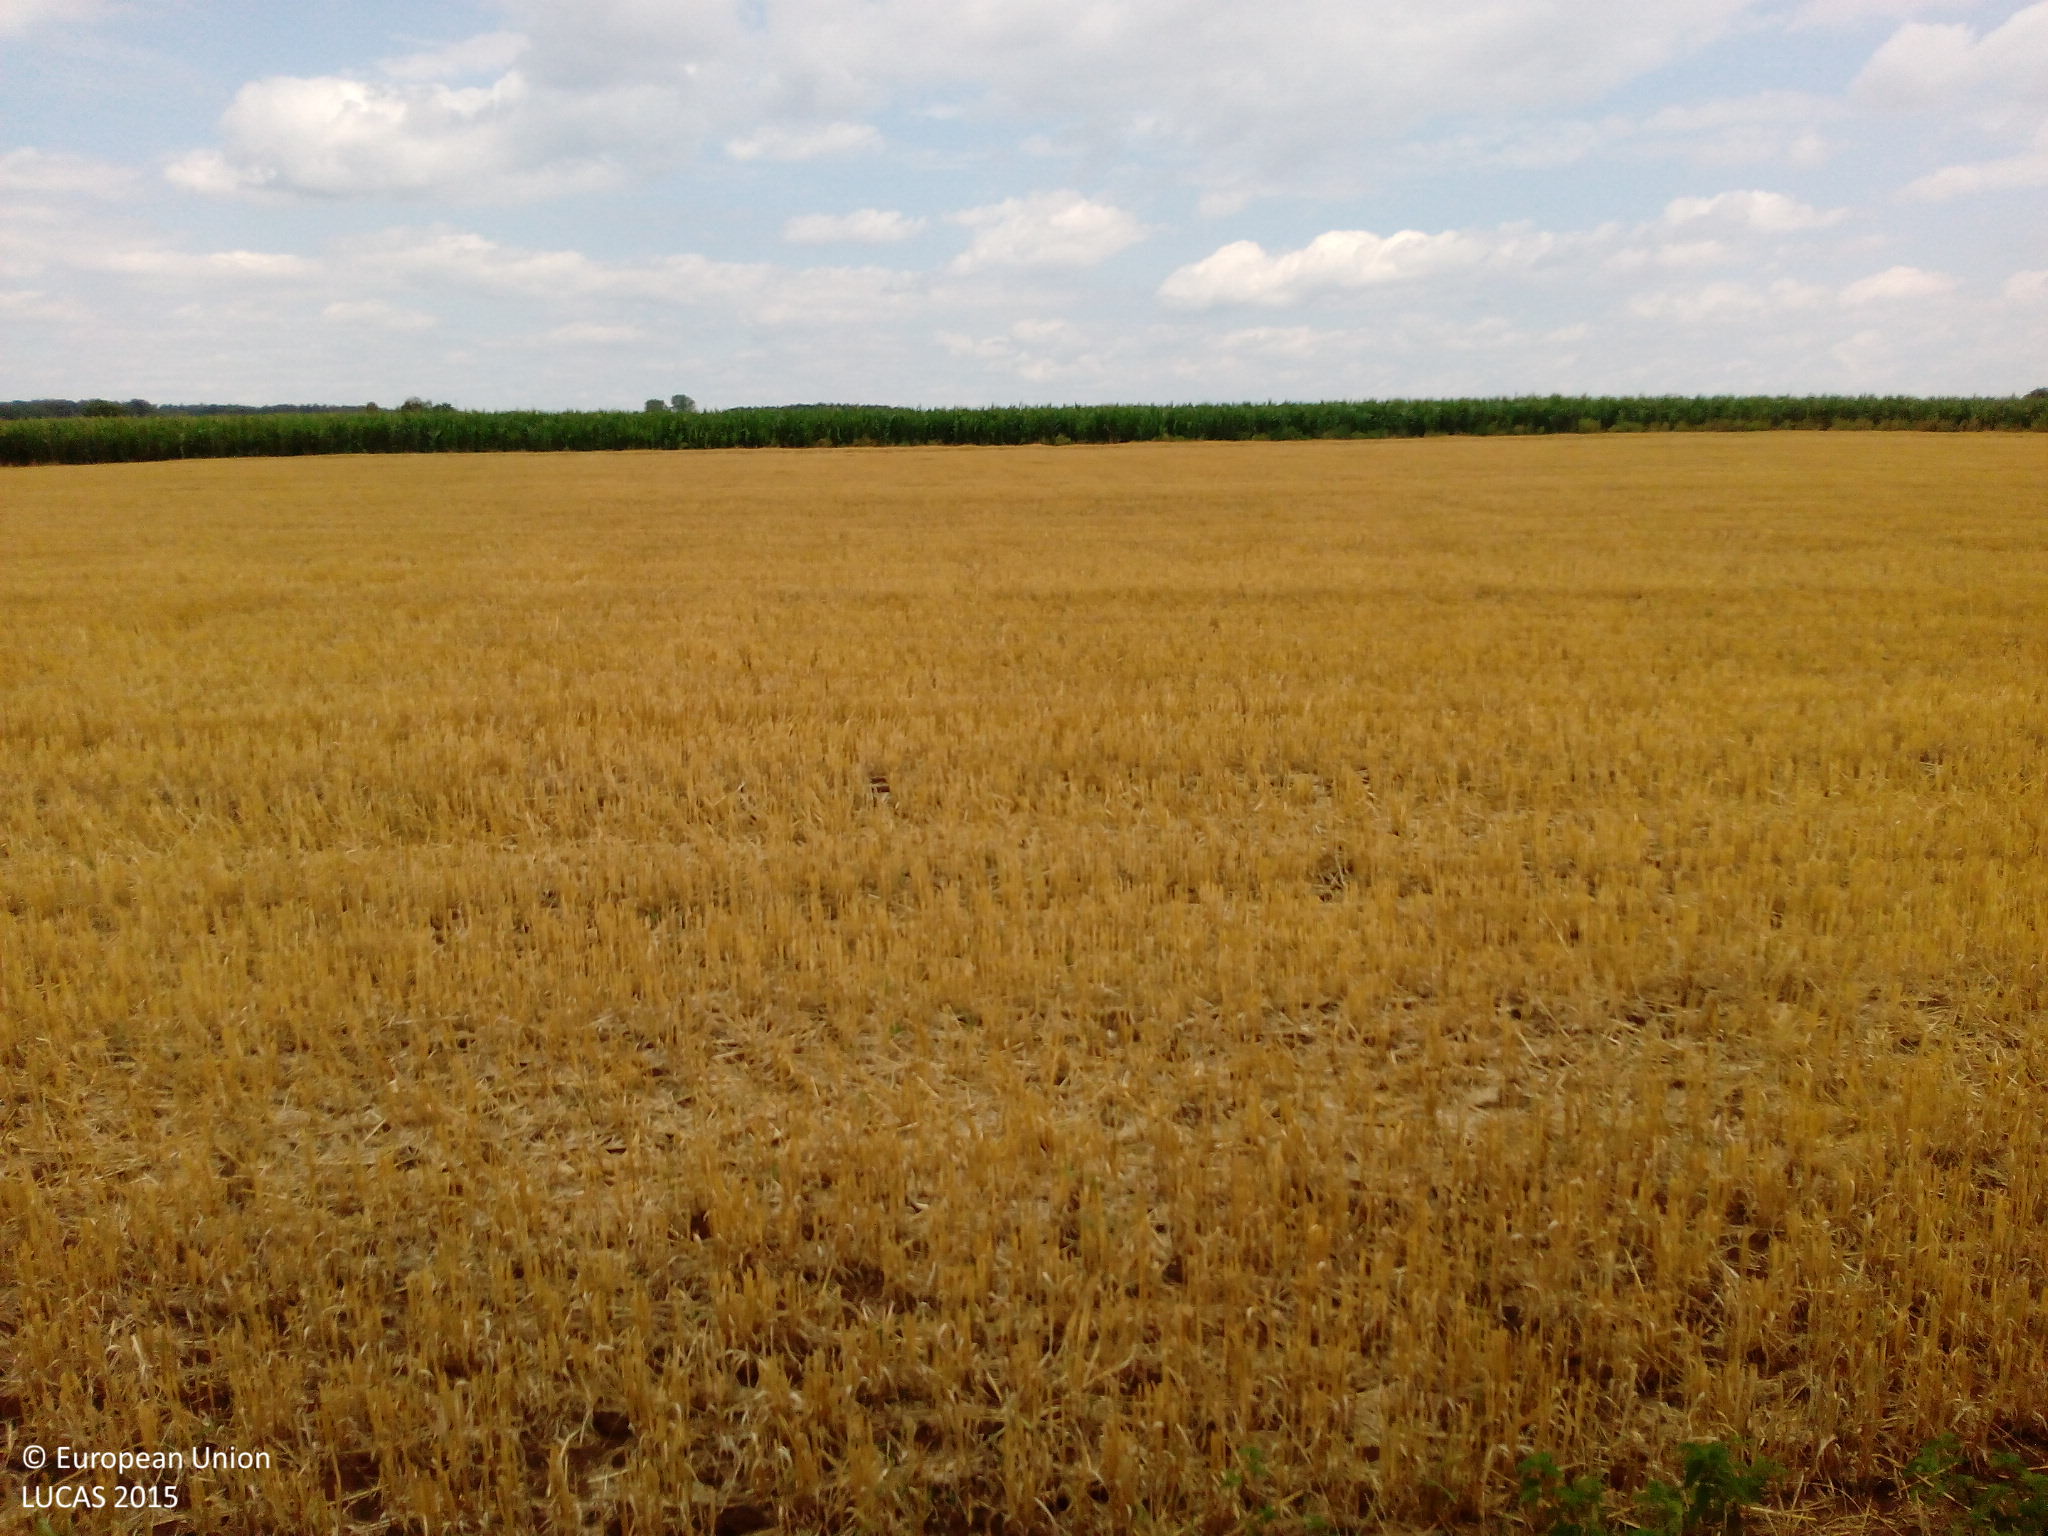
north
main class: Grassland
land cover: Grassland without tree/shrub cover
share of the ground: > 75 %
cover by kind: herbaceous plants 90 %, unconsolidated bare surface 10 %
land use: Agriculture (excluding fallow land and kitchen gardens)
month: July
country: DE
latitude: 49.5330
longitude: 10.9254
